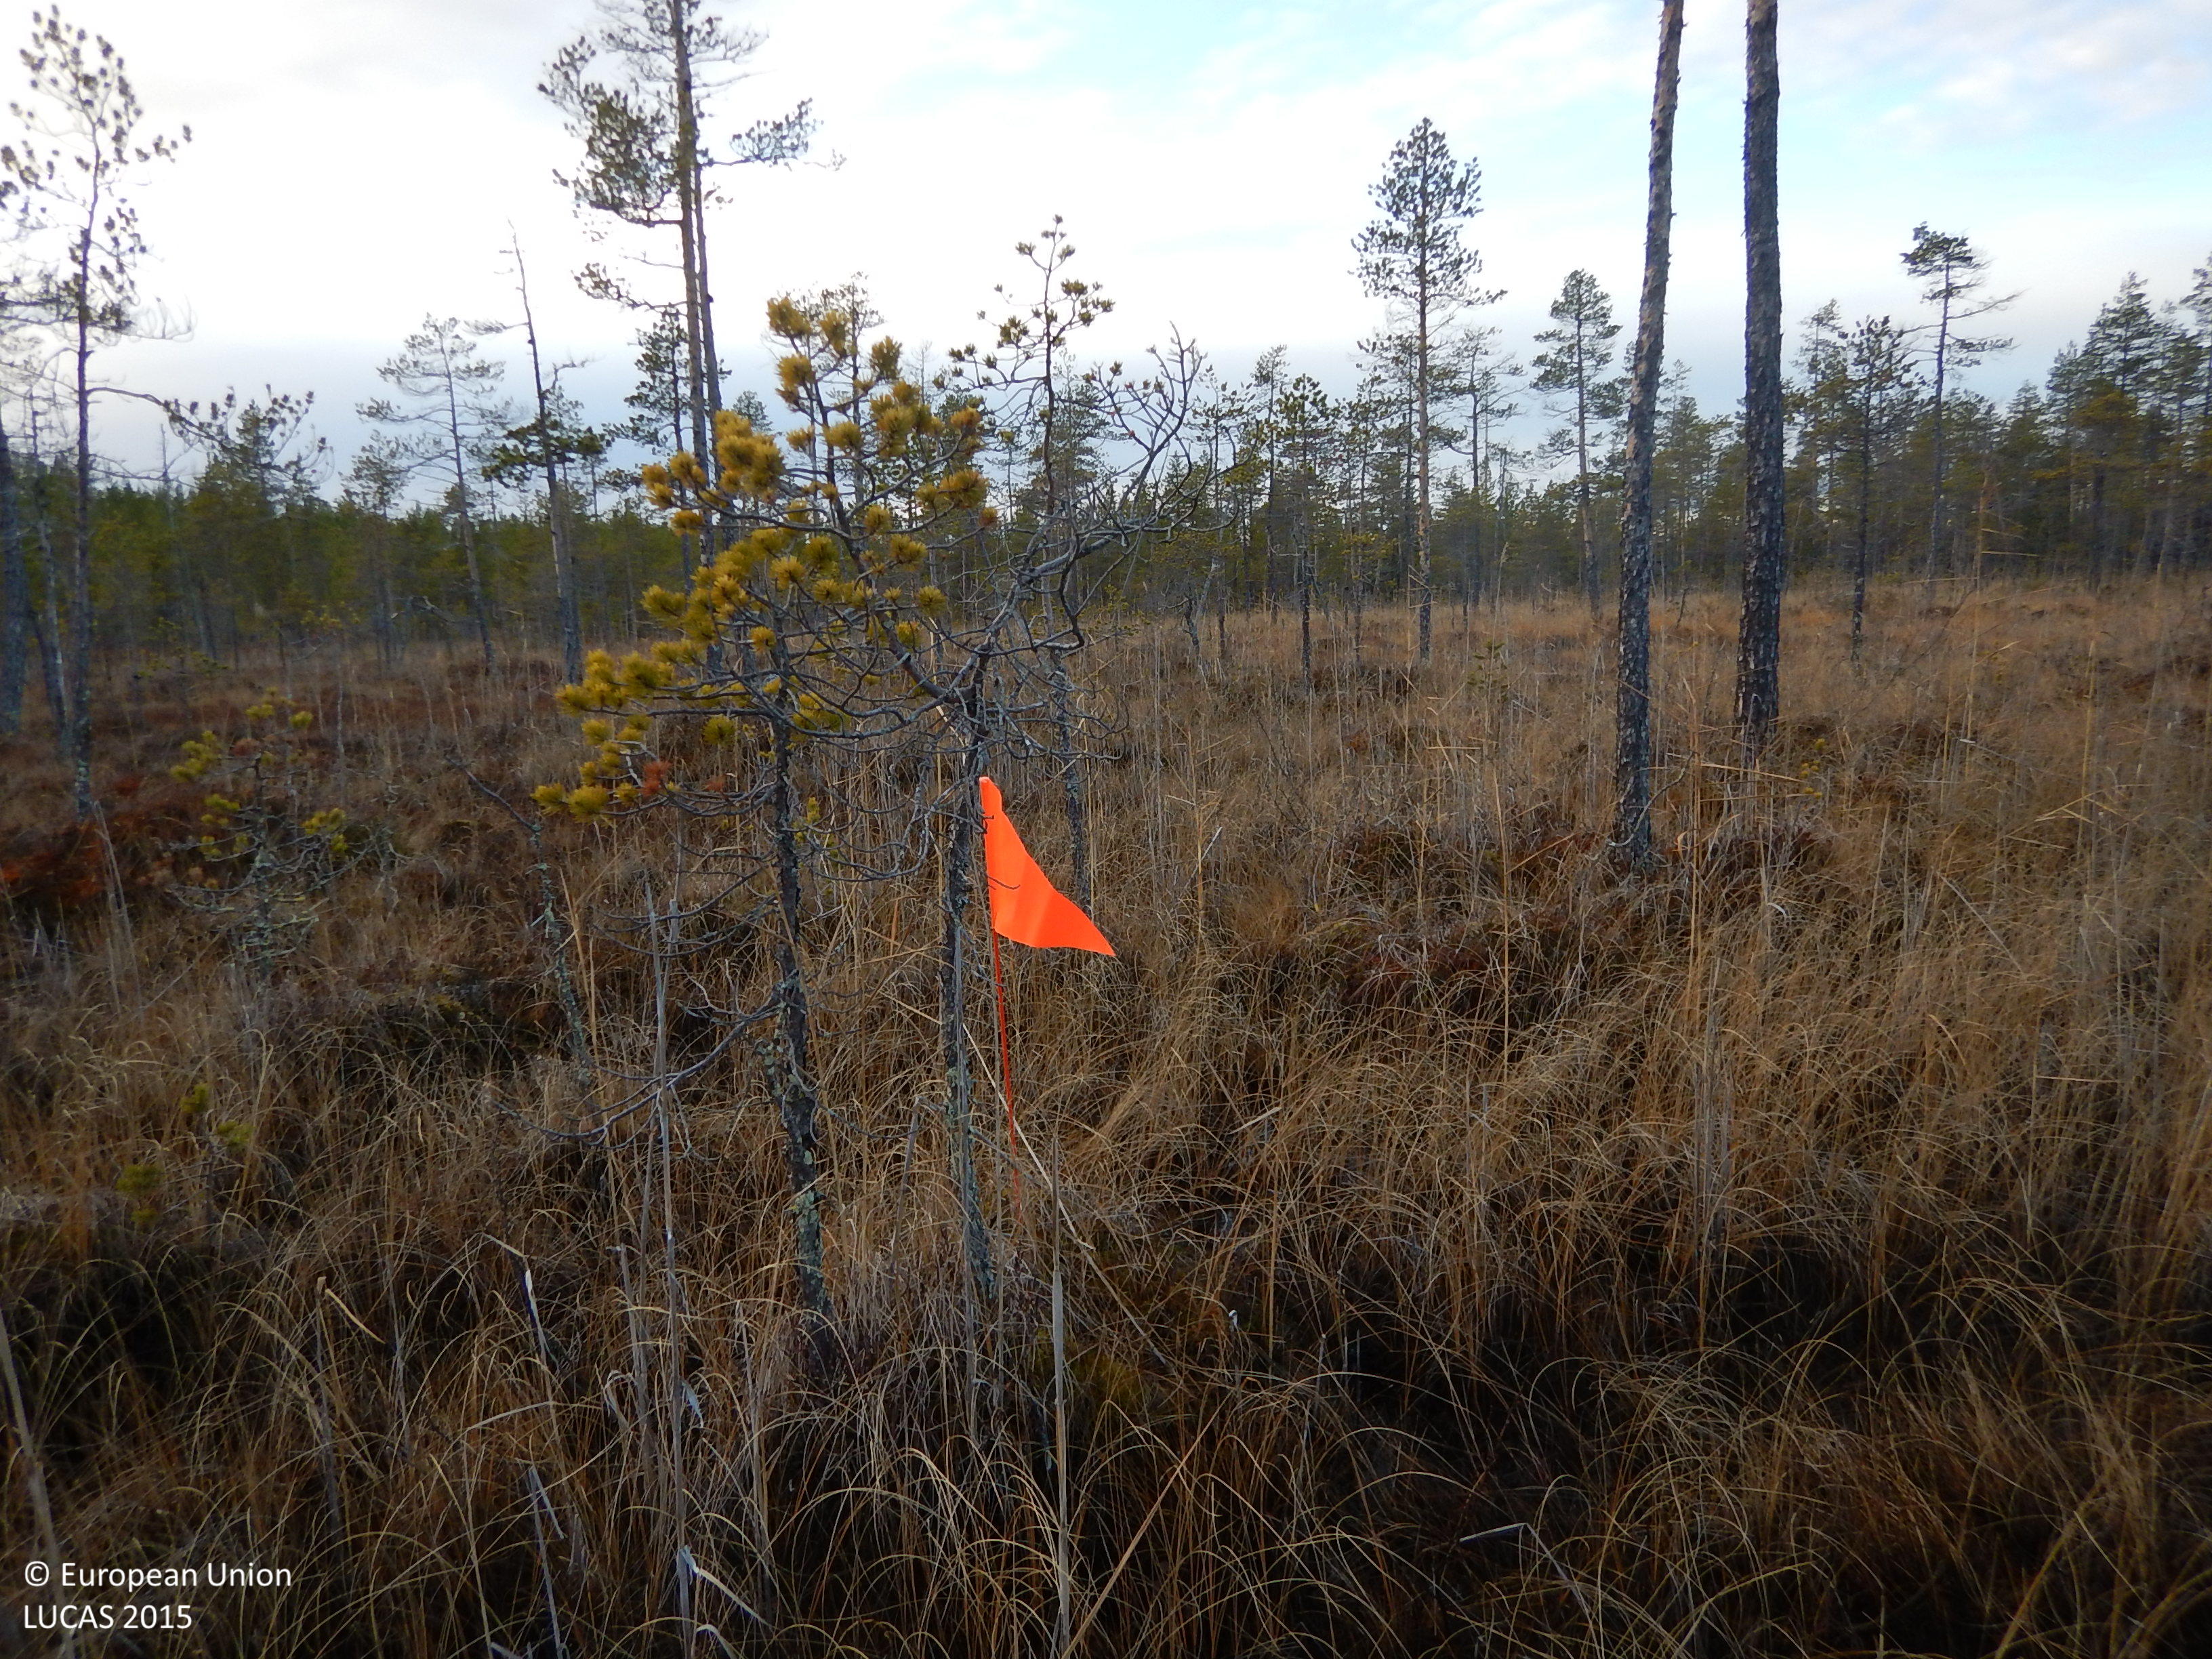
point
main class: Woodland
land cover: Pine dominated coniferous woodland
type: mire and swamp forests
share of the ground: 25 - 50 %
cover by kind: coniferous forest trees 30 %, lichens and mosses 30 %, herbaceous plants 20 %, shrubs 15 %, broadleaved forest trees 5 %
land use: Semi-natural and natural areas not in use
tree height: < 5 m
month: October
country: SE
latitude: 65.3201
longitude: 20.0329
